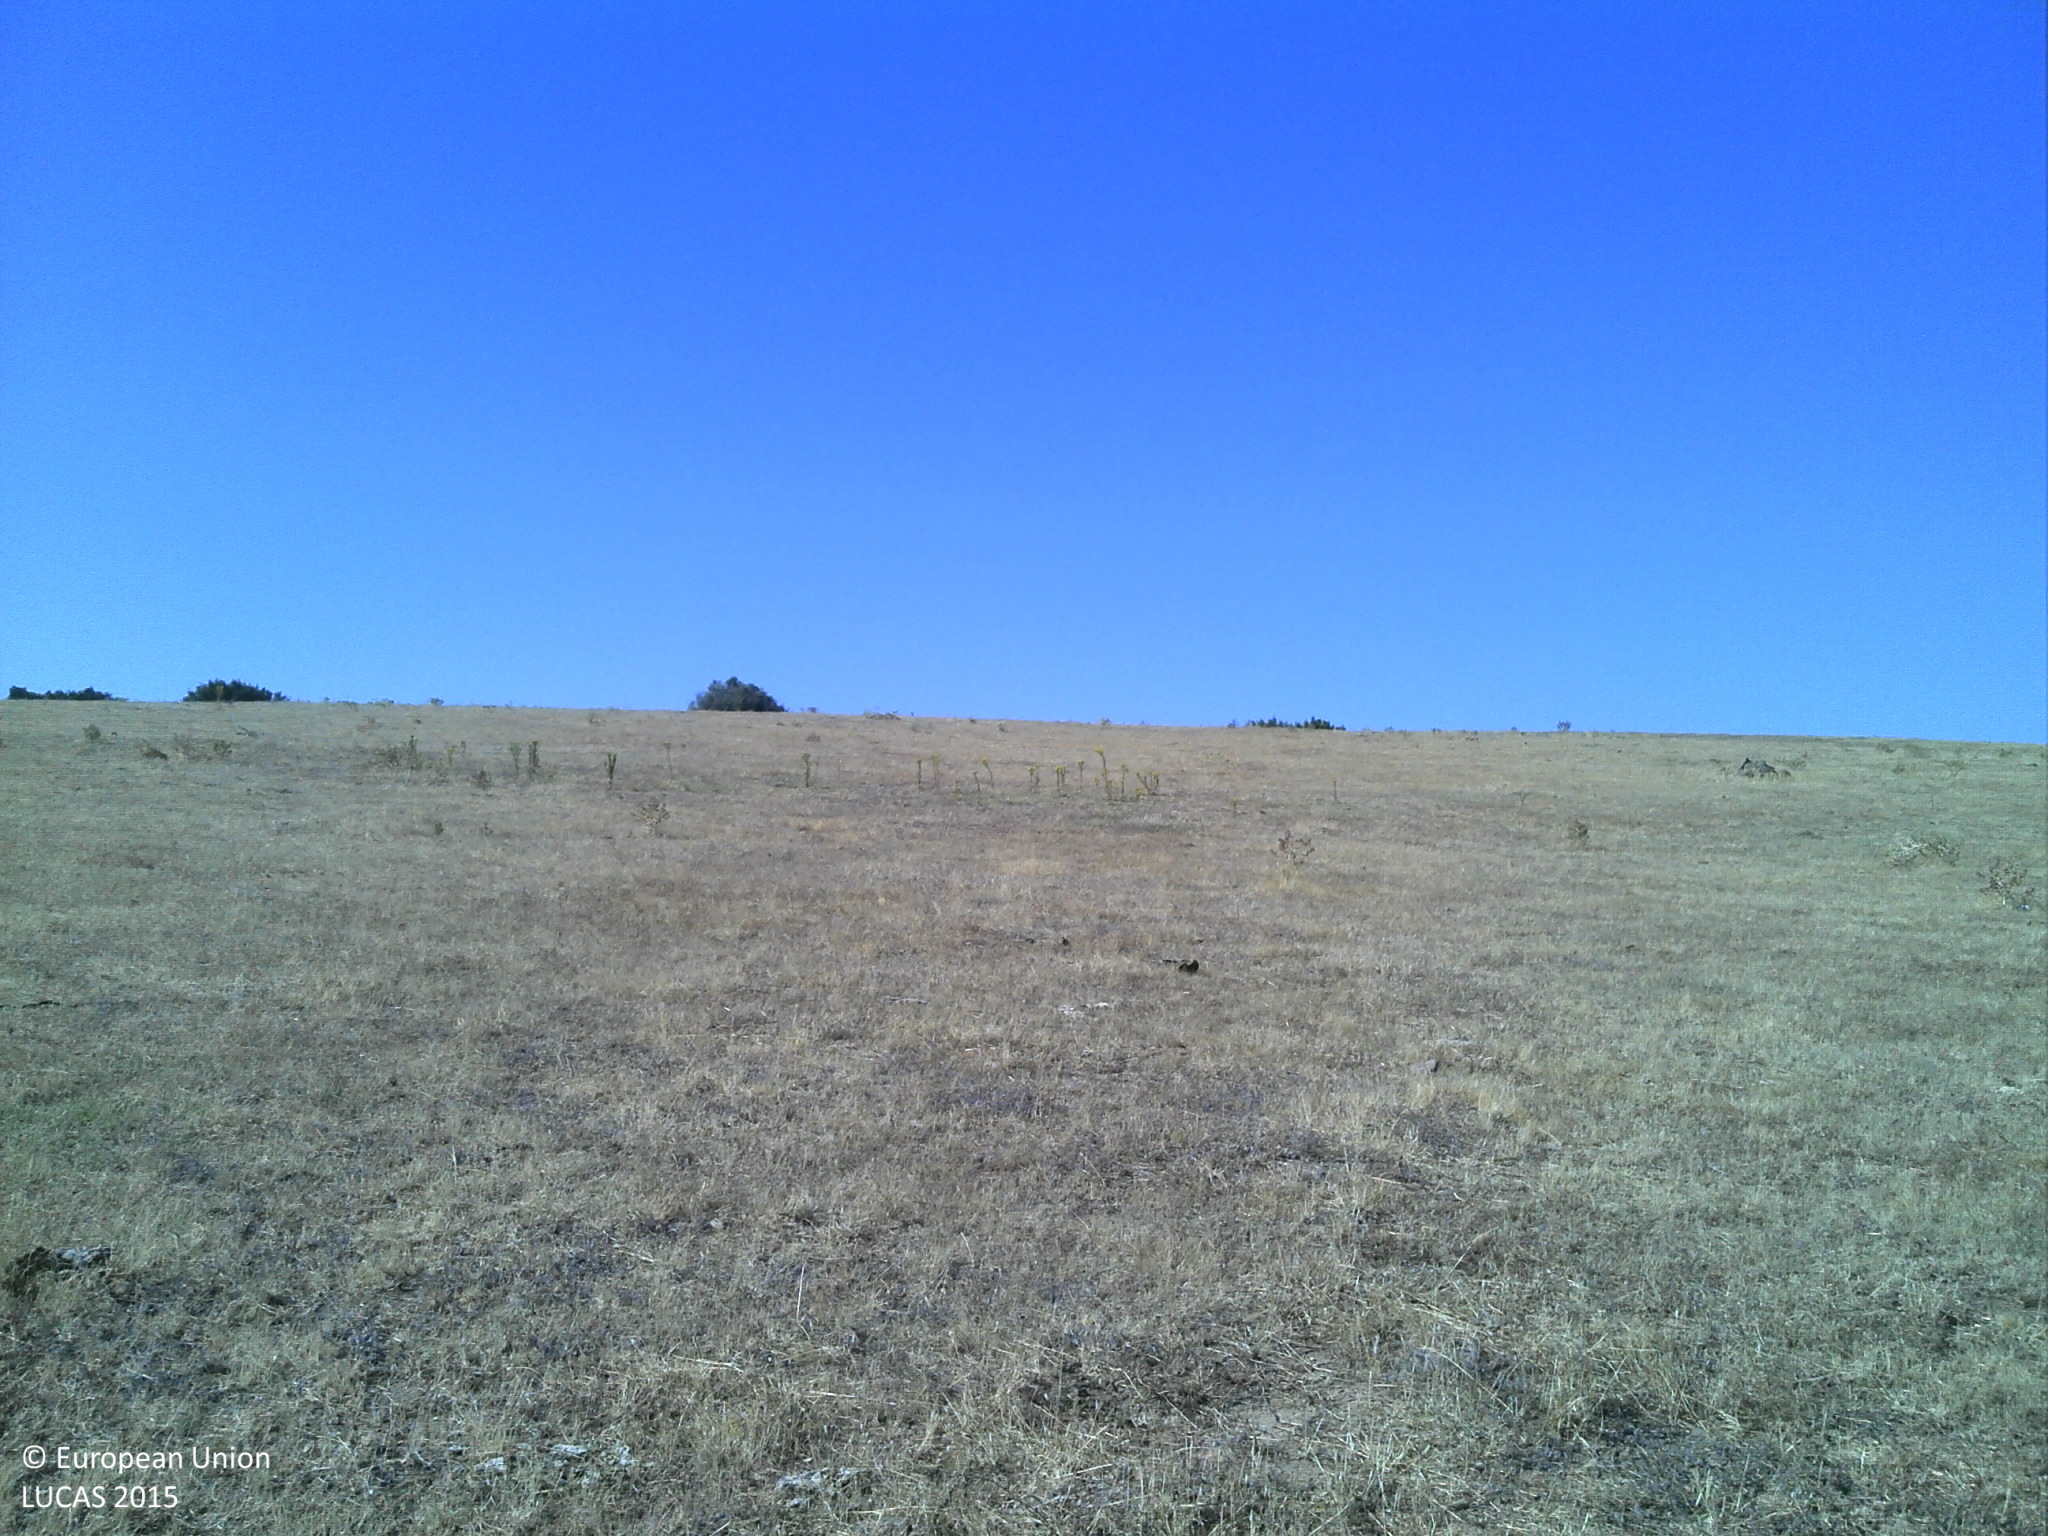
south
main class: Grassland
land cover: Grassland without tree/shrub cover
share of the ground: 25 - 50 %
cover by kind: unconsolidated bare surface 70 %, herbaceous plants 30 %
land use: Agriculture (excluding fallow land and kitchen gardens)
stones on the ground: < 10 %
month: July
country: PT
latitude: 39.0667
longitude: -7.4079
